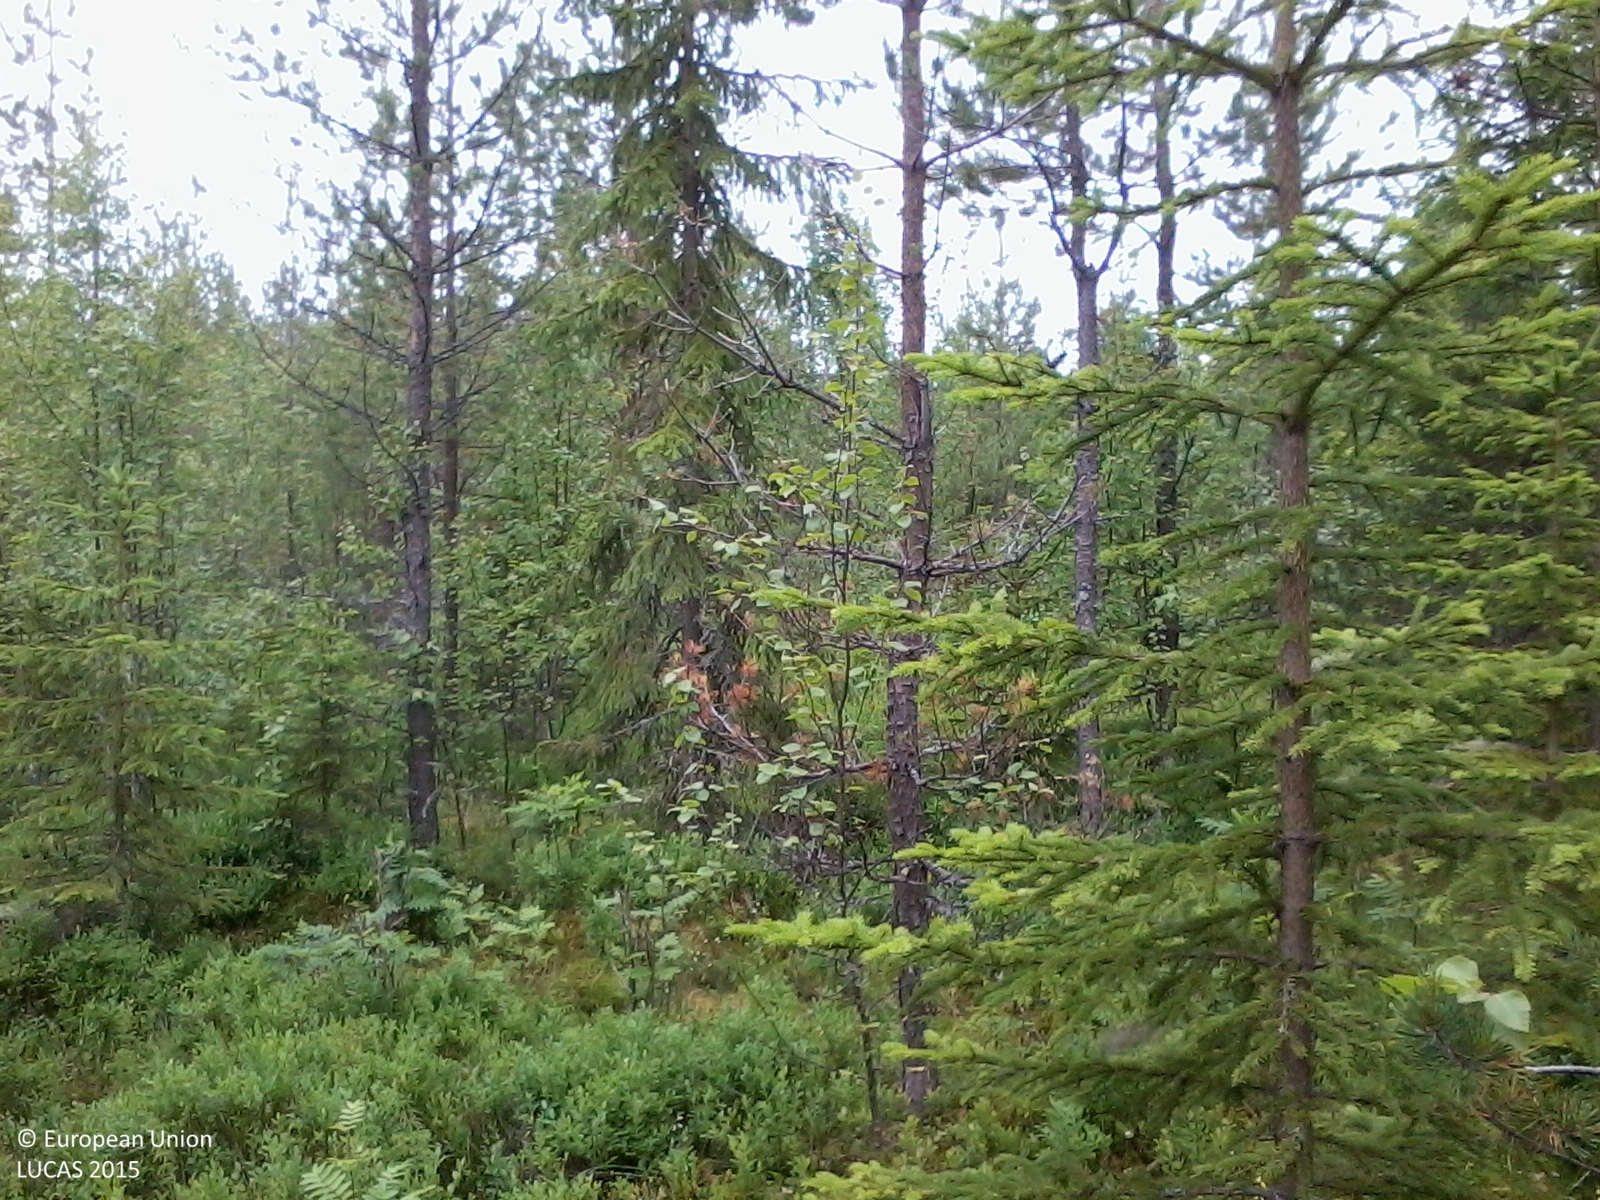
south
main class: Woodland
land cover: Pine dominated mixed woodland
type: boreal forest
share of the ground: 50 - 75 %
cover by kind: coniferous forest trees 50 %, broadleaved forest trees 20 %, shrubs 15 %, herbaceous plants 10 %, lichens and mosses 5 %
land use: Forestry
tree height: < 5 m
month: July
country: SE
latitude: 63.5521
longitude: 18.1654
